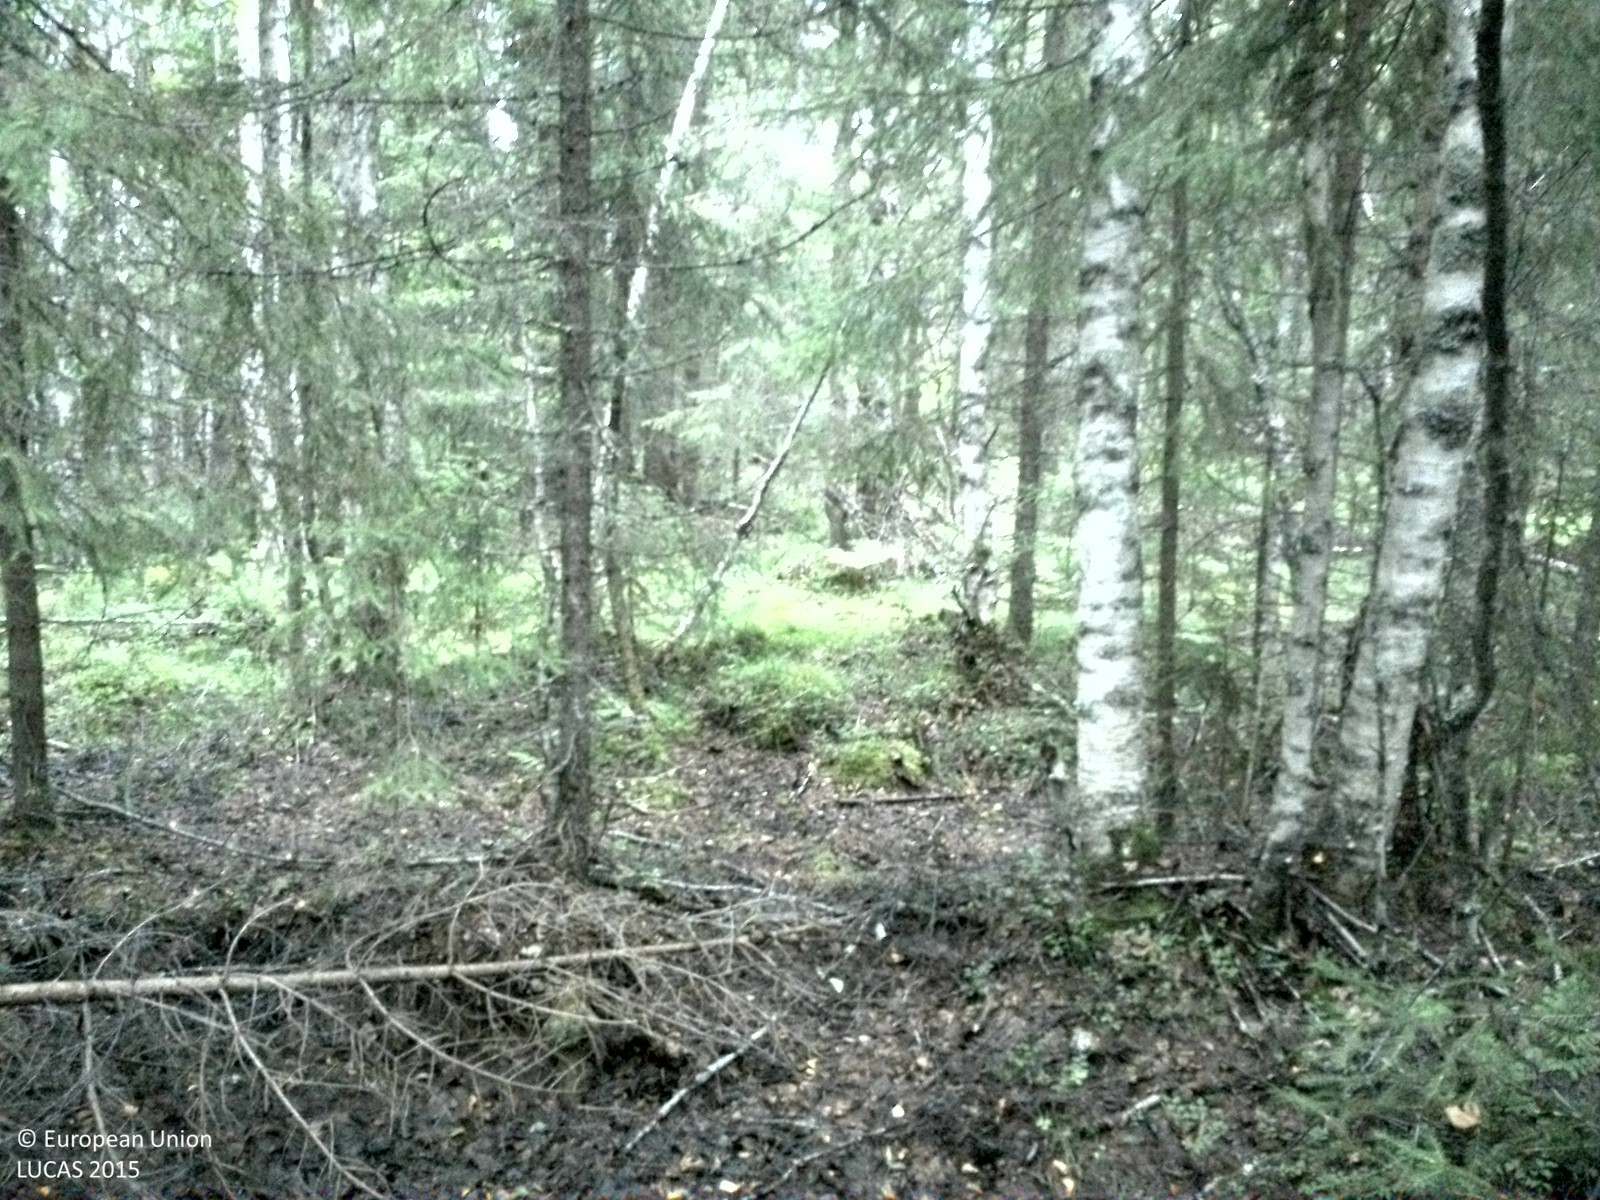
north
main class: Woodland
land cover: Spruce dominated mixed woodland
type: boreal forest
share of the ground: > 75 %
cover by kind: coniferous forest trees 50 %, broadleaved forest trees 30 %, lichens and mosses 10 %, unconsolidated bare surface 10 %
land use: Forestry
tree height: > 5 m
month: August
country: SE
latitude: 62.7301
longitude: 16.8057
